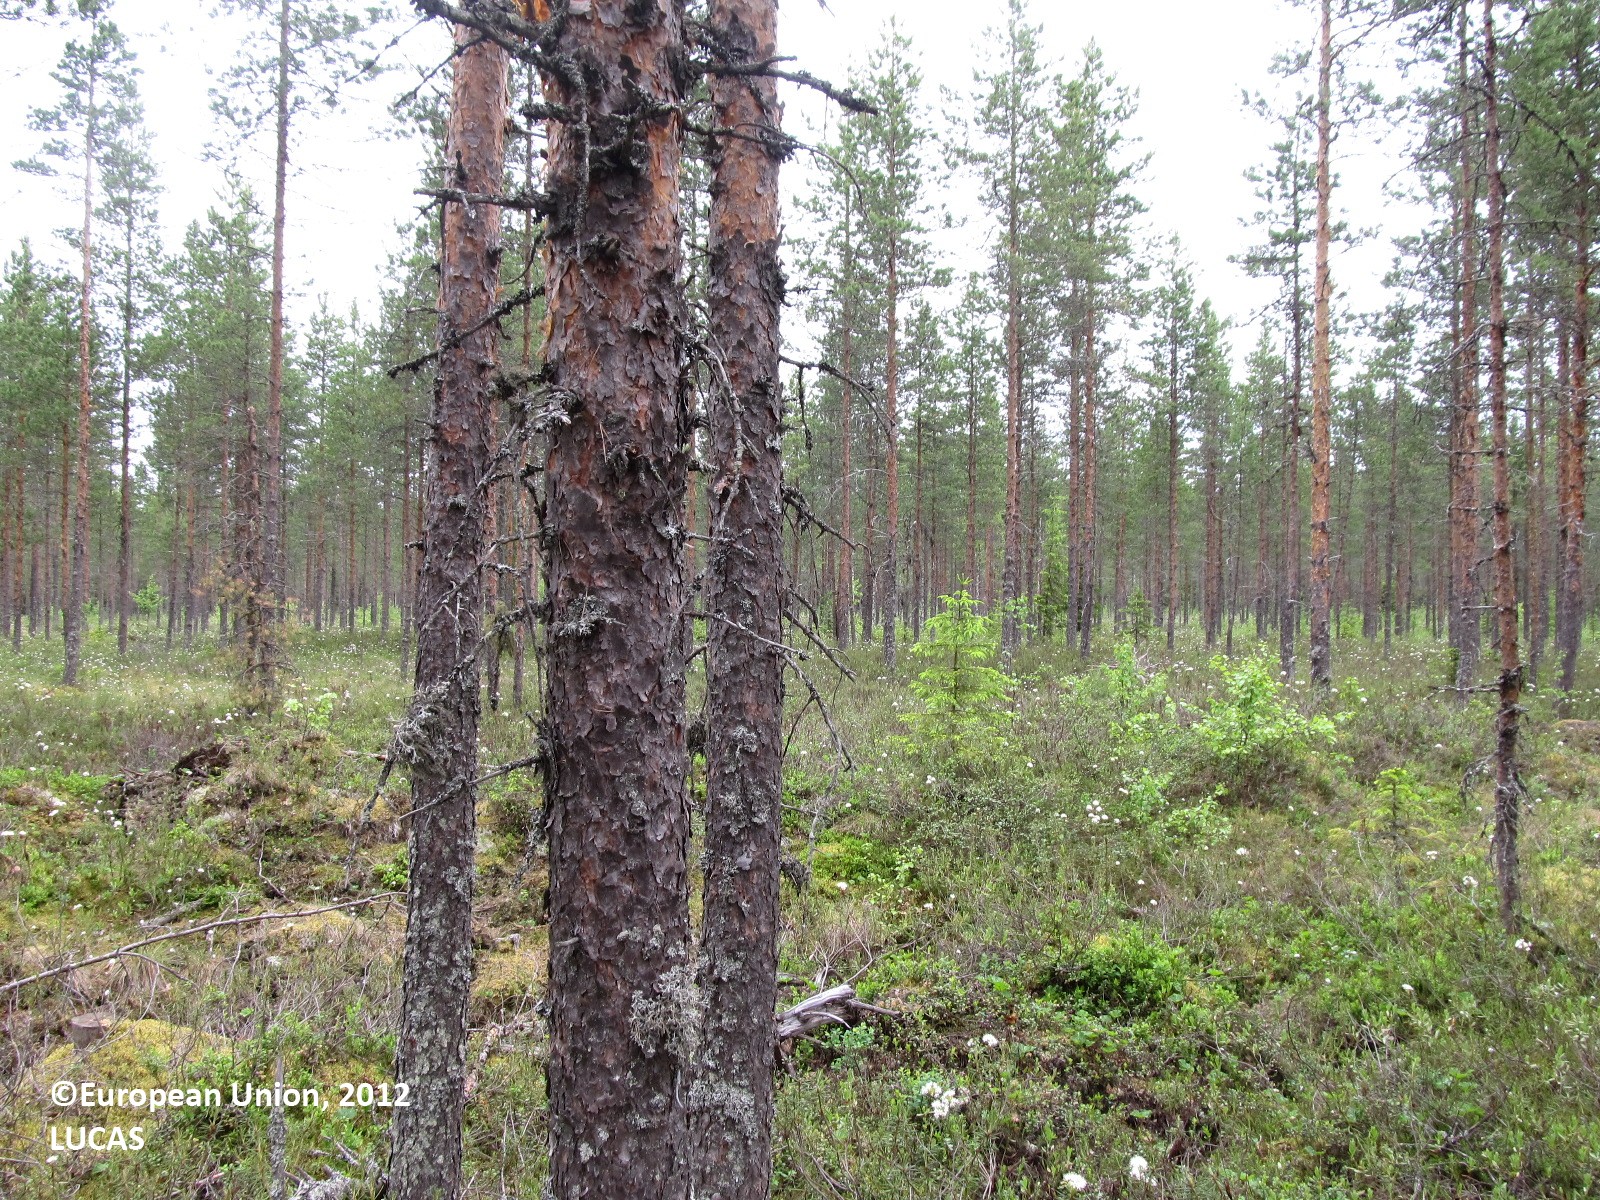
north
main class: Woodland
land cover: Pine dominated coniferous woodland
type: boreal forest
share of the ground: 25 - 50 %
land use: Forestry
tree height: > 5 m
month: June
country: FI
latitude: 63.3010
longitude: 27.8237
